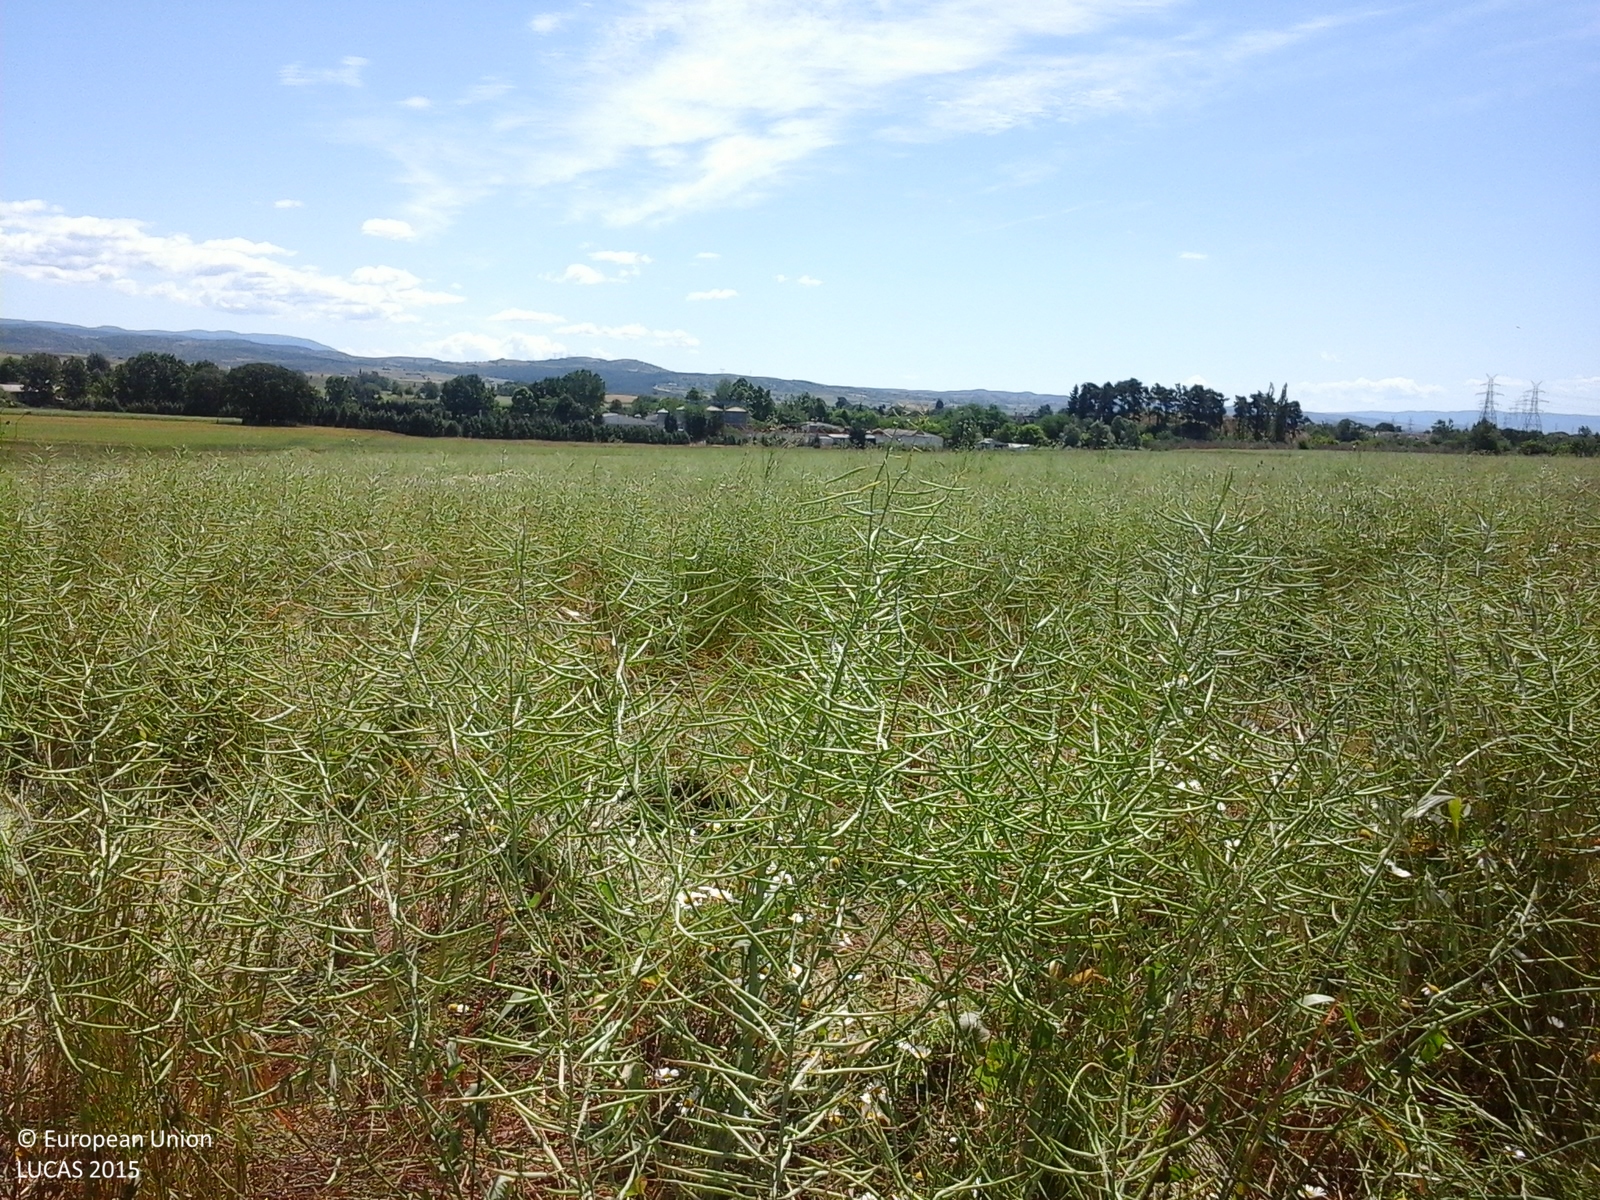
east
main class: Cropland
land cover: Rape and turnip rape
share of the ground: > 75 %
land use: Agriculture (excluding fallow land and kitchen gardens)
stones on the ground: < 10 %
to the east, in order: Rape and turnip rape; Common wheat; Other bare soil; Common wheat
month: May
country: GR
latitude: 40.8052
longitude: 23.0134
